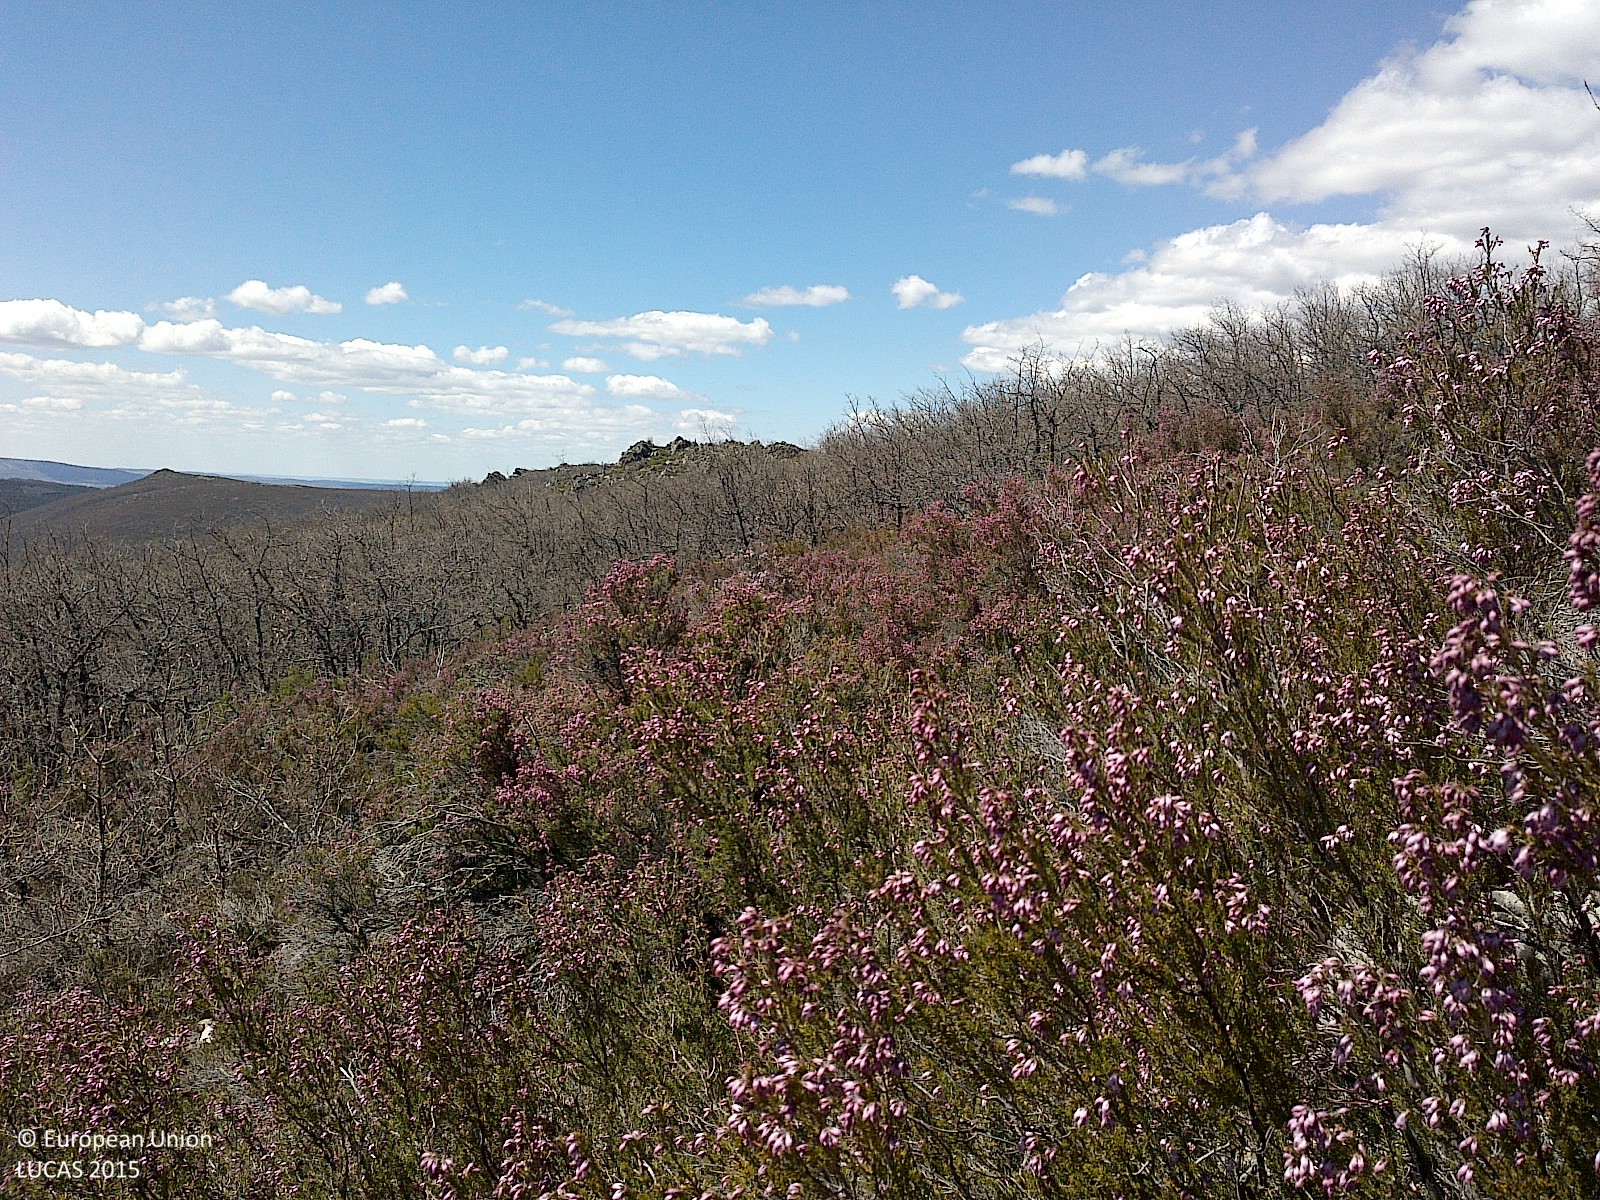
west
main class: Woodland
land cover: Broadleaved woodland
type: thermophilous deciduous forest
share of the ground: 10 - 25 %
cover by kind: shrubs 65 %, broadleaved forest trees 20 %, consolidated bare surface 10 %, herbaceous plants 5 %
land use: Semi-natural and natural areas not in use
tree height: < 5 m
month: April
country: ES
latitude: 42.1444
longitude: -3.2532
